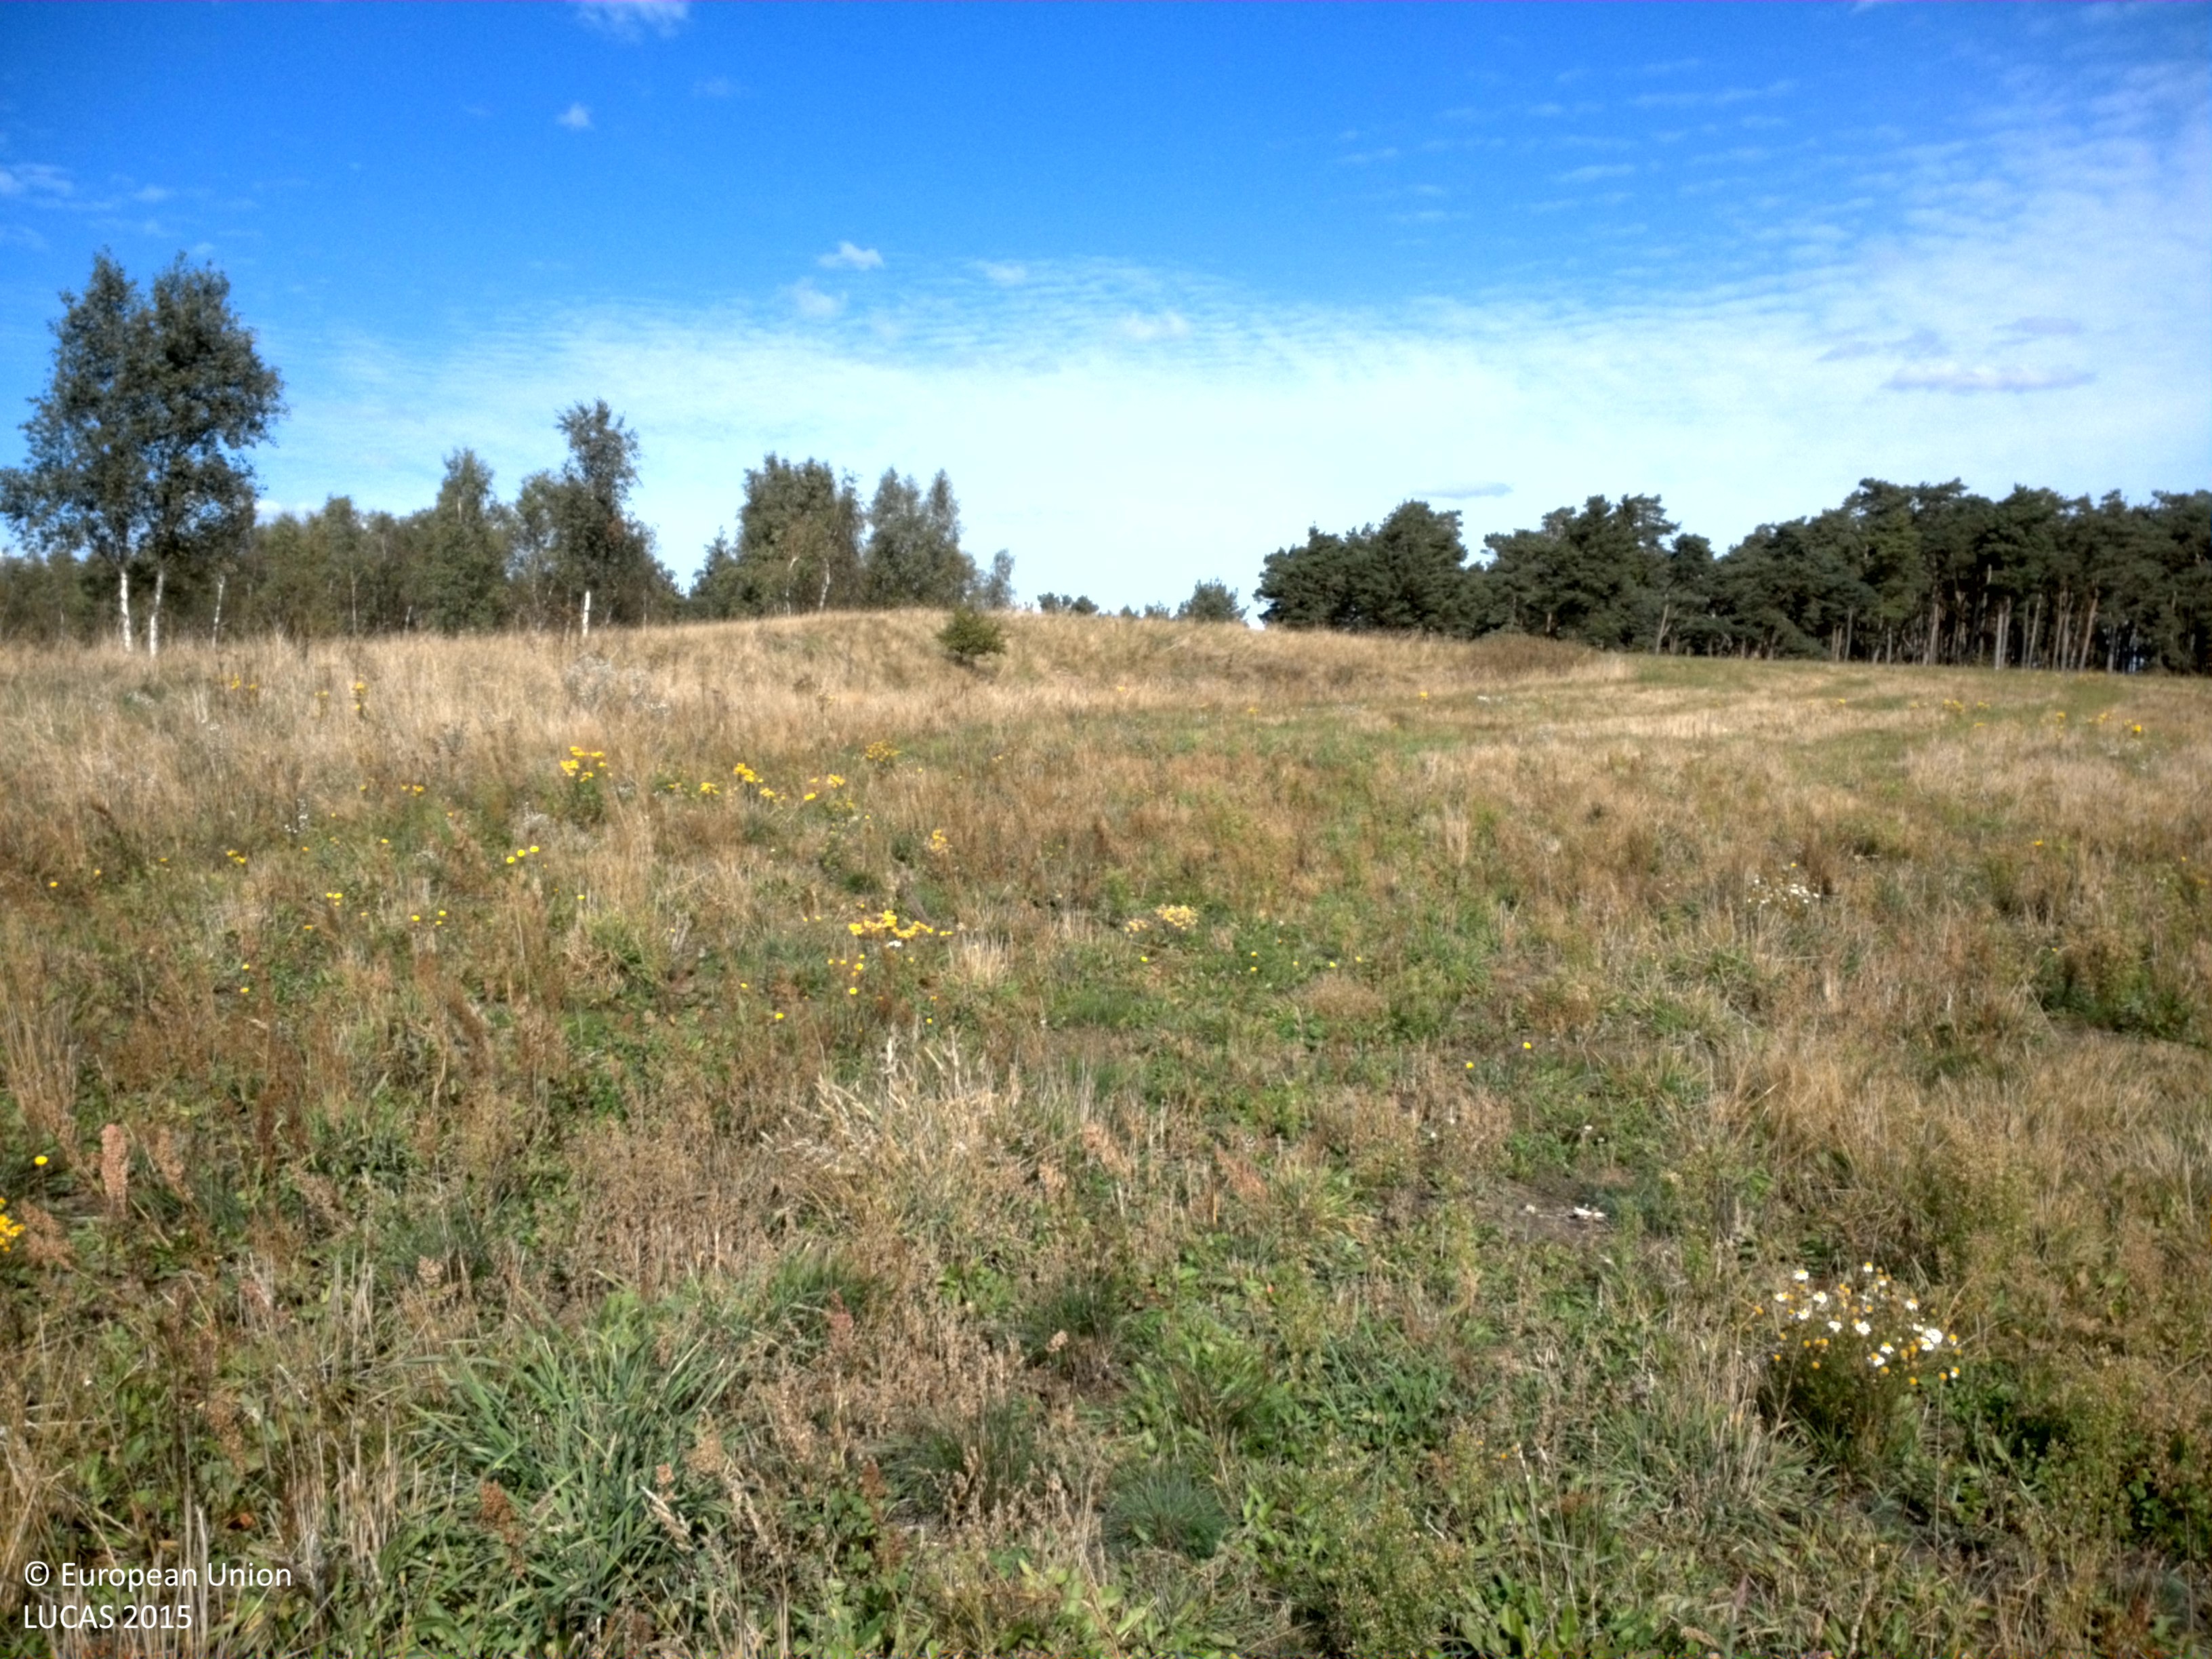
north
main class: Grassland
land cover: Grassland without tree/shrub cover
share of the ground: > 75 %
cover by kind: herbaceous plants 100 %
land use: Agriculture (excluding fallow land and kitchen gardens)
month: September
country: SE
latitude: 55.6136
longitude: 13.6656
